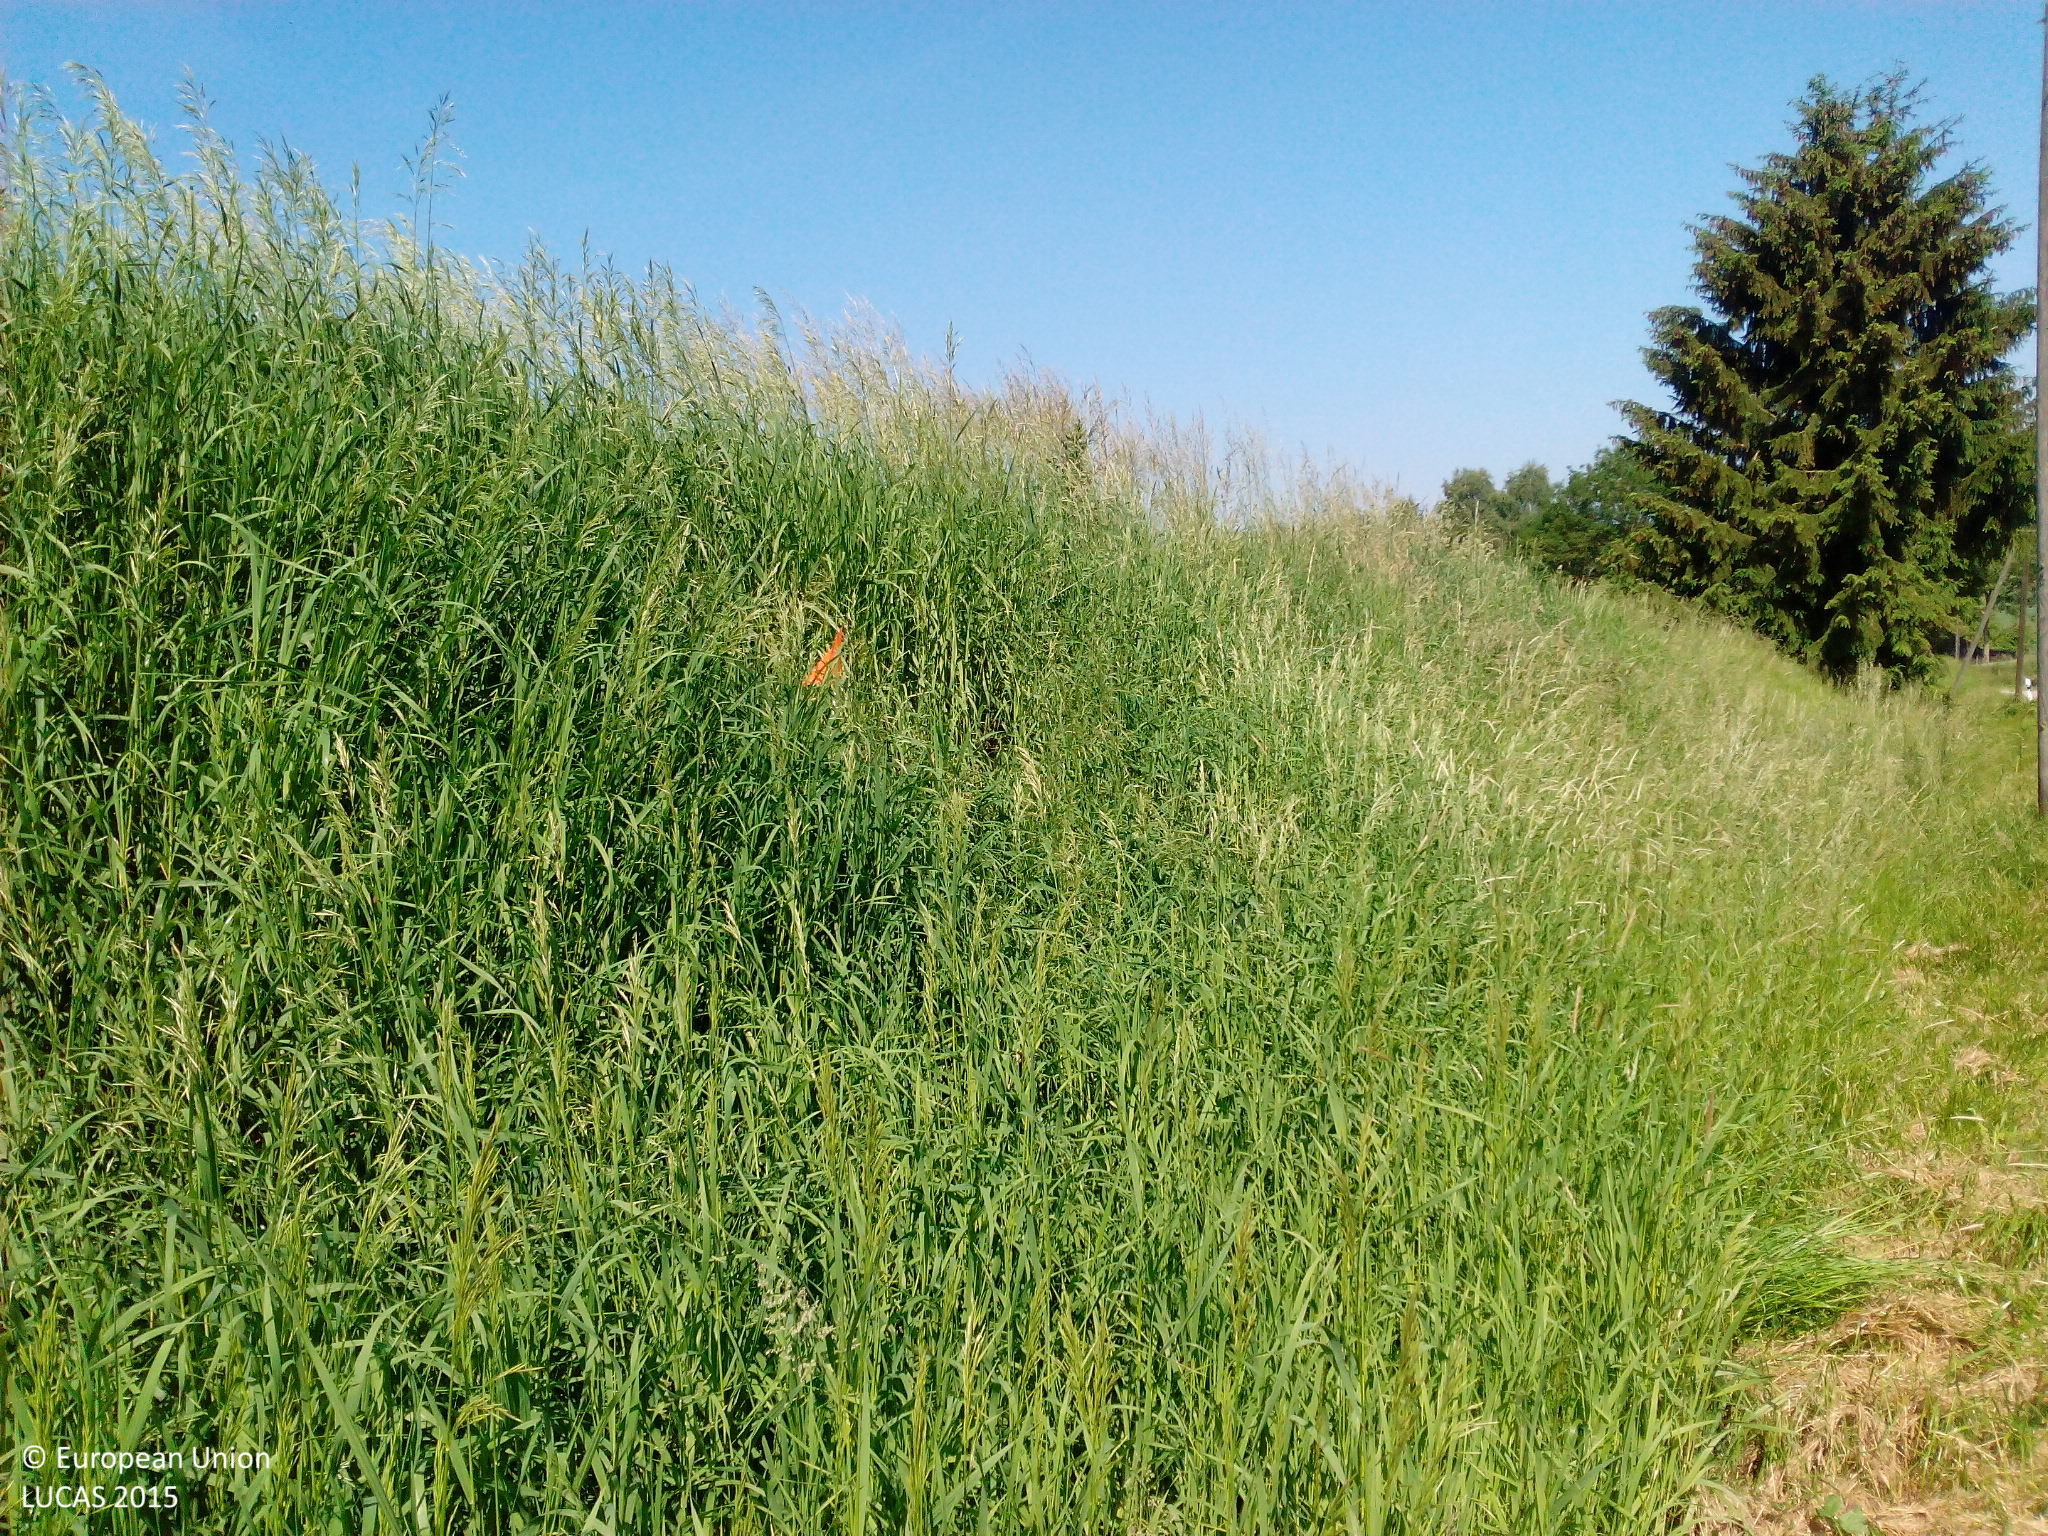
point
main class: Grassland
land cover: Grassland without tree/shrub cover
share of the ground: > 75 %
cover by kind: herbaceous plants 100 %
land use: Agriculture (excluding fallow land and kitchen gardens)
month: June
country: DE
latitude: 48.6834
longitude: 12.4034
